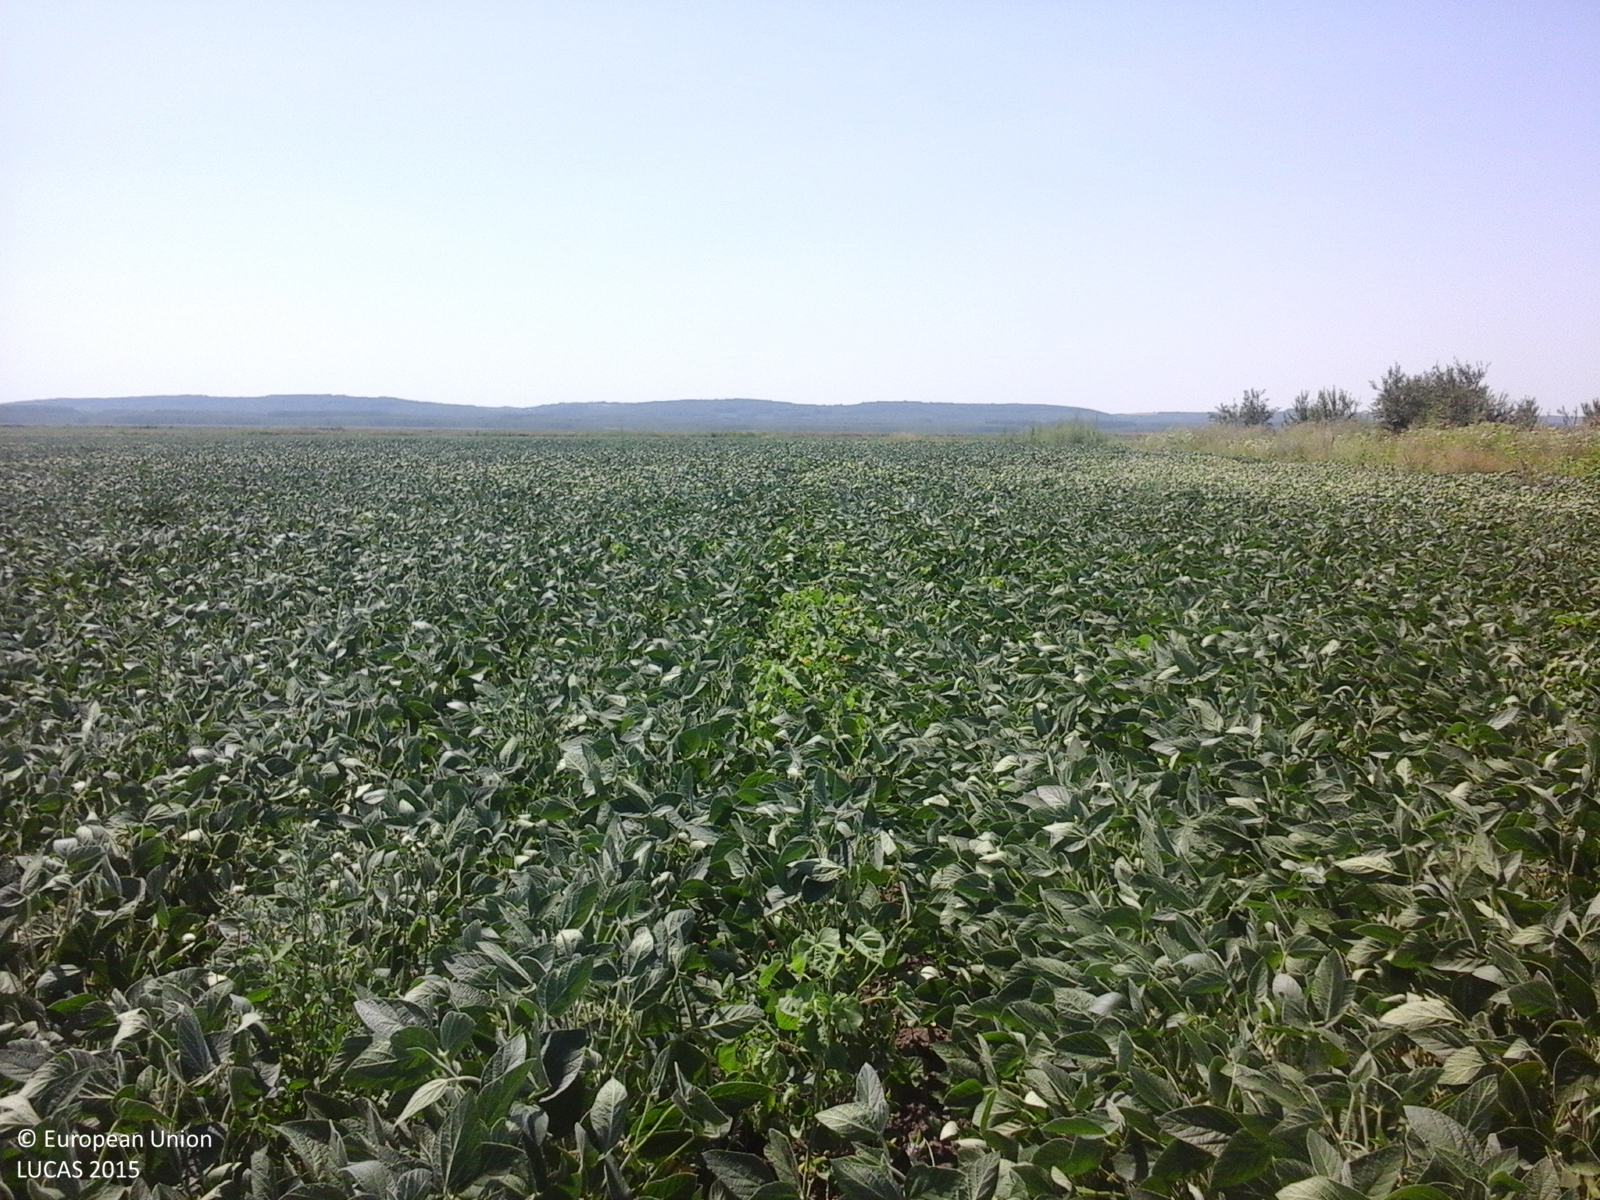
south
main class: Cropland
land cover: Soya
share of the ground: > 75 %
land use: Agriculture (excluding fallow land and kitchen gardens)
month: July
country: RO
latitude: 44.1822
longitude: 27.0260
